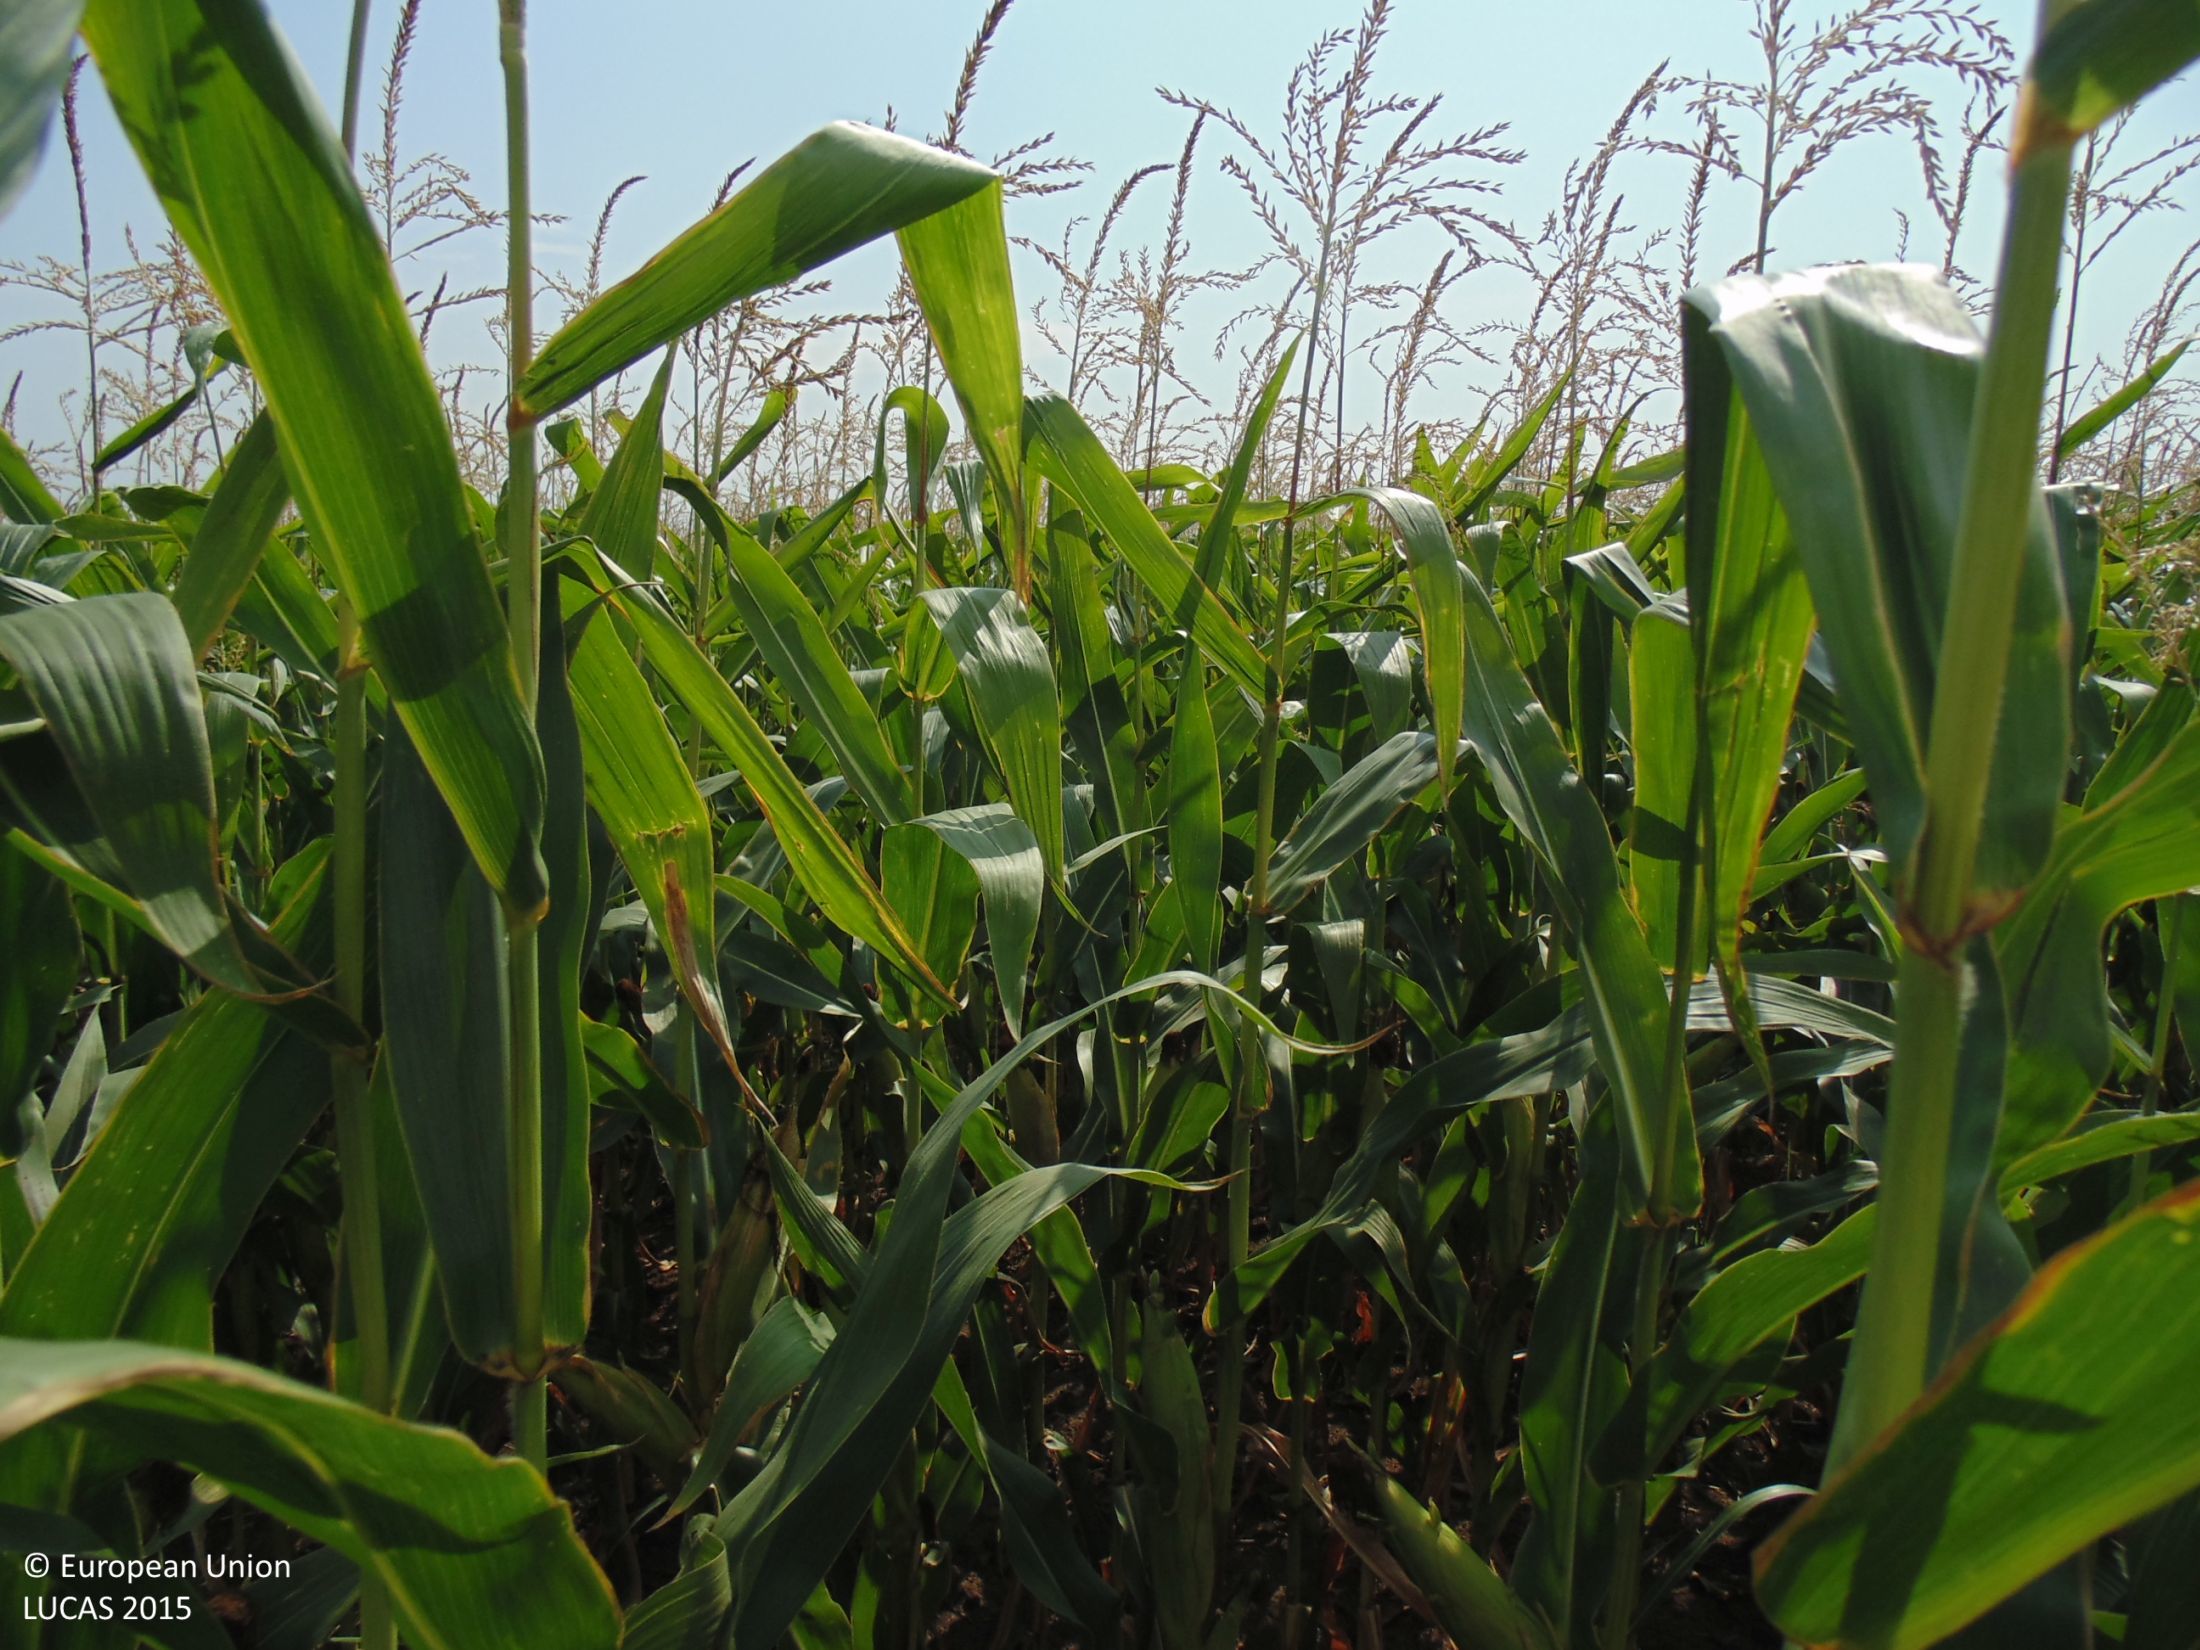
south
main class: Cropland
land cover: Maize
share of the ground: > 75 %
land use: Agriculture (excluding fallow land and kitchen gardens)
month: August
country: BG
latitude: 43.8226
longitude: 28.0434
